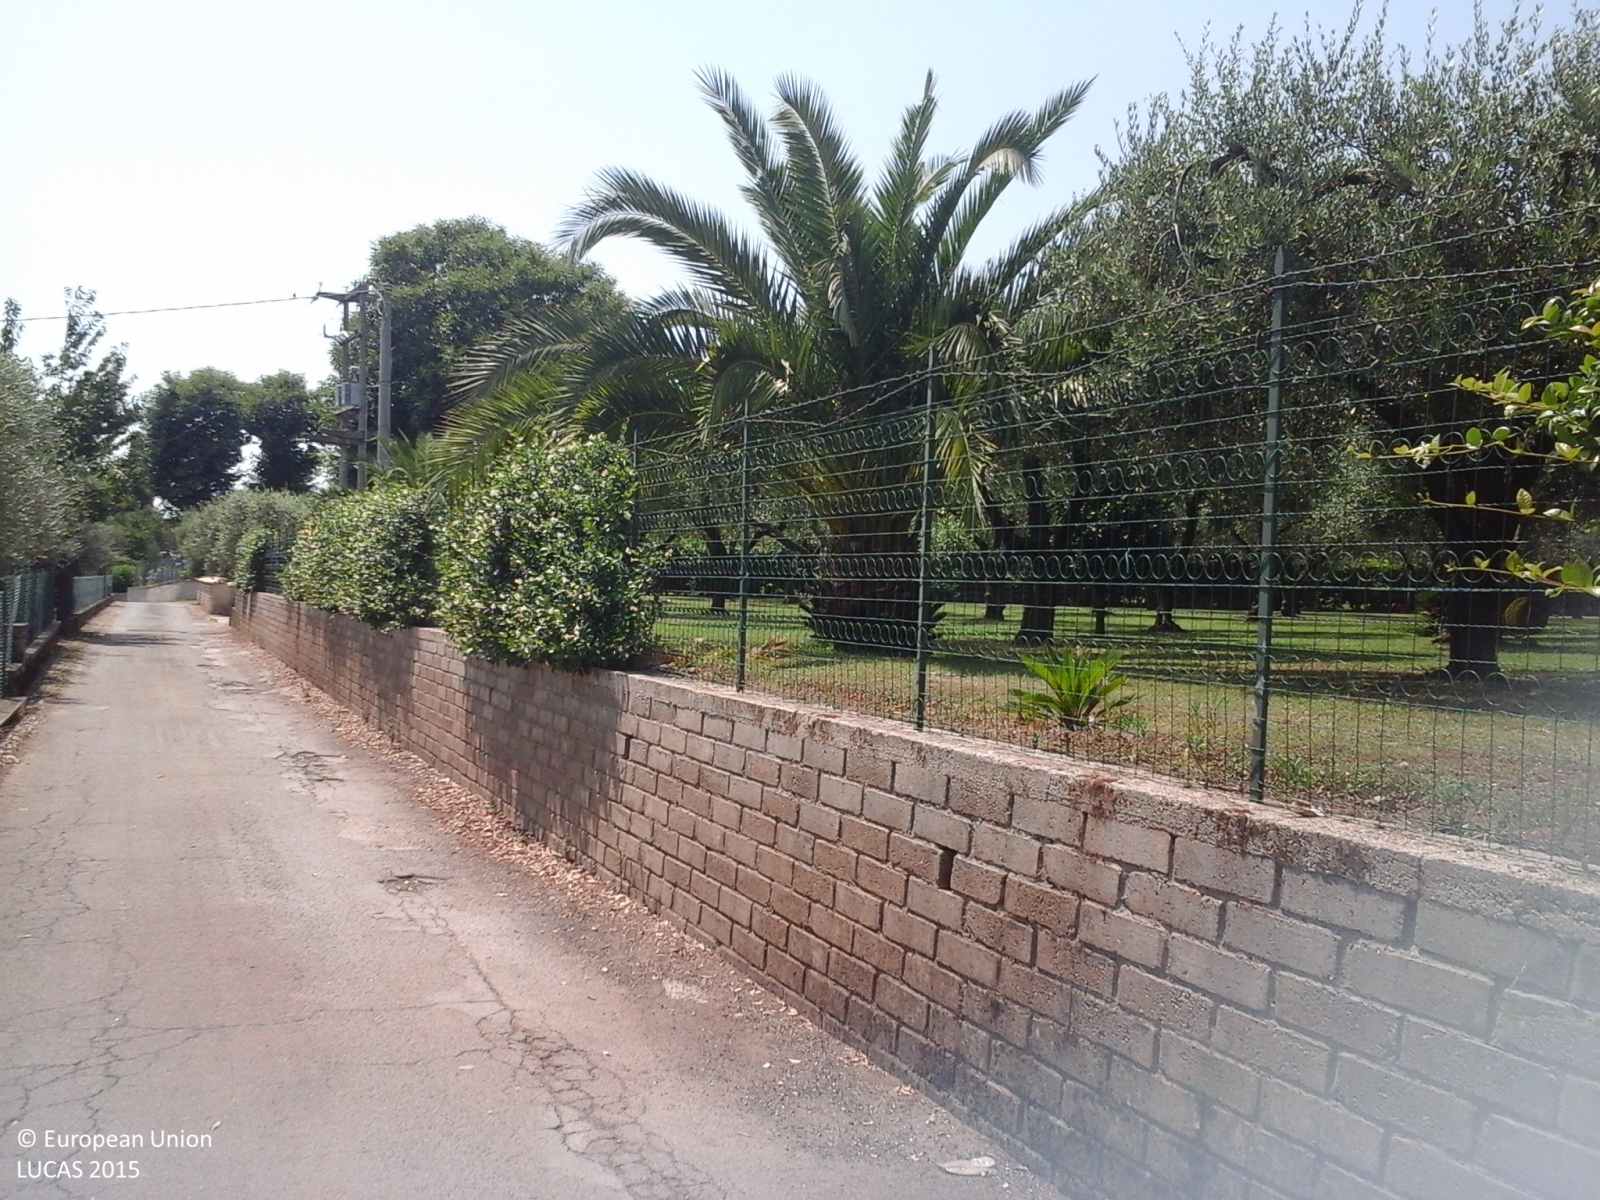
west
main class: Cropland
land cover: Olive groves
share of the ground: 50 - 75 %
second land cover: Grassland without tree/shrub cover
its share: > 75 %
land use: Kitchen garden
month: July
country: IT
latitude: 41.6930
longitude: 12.8128
